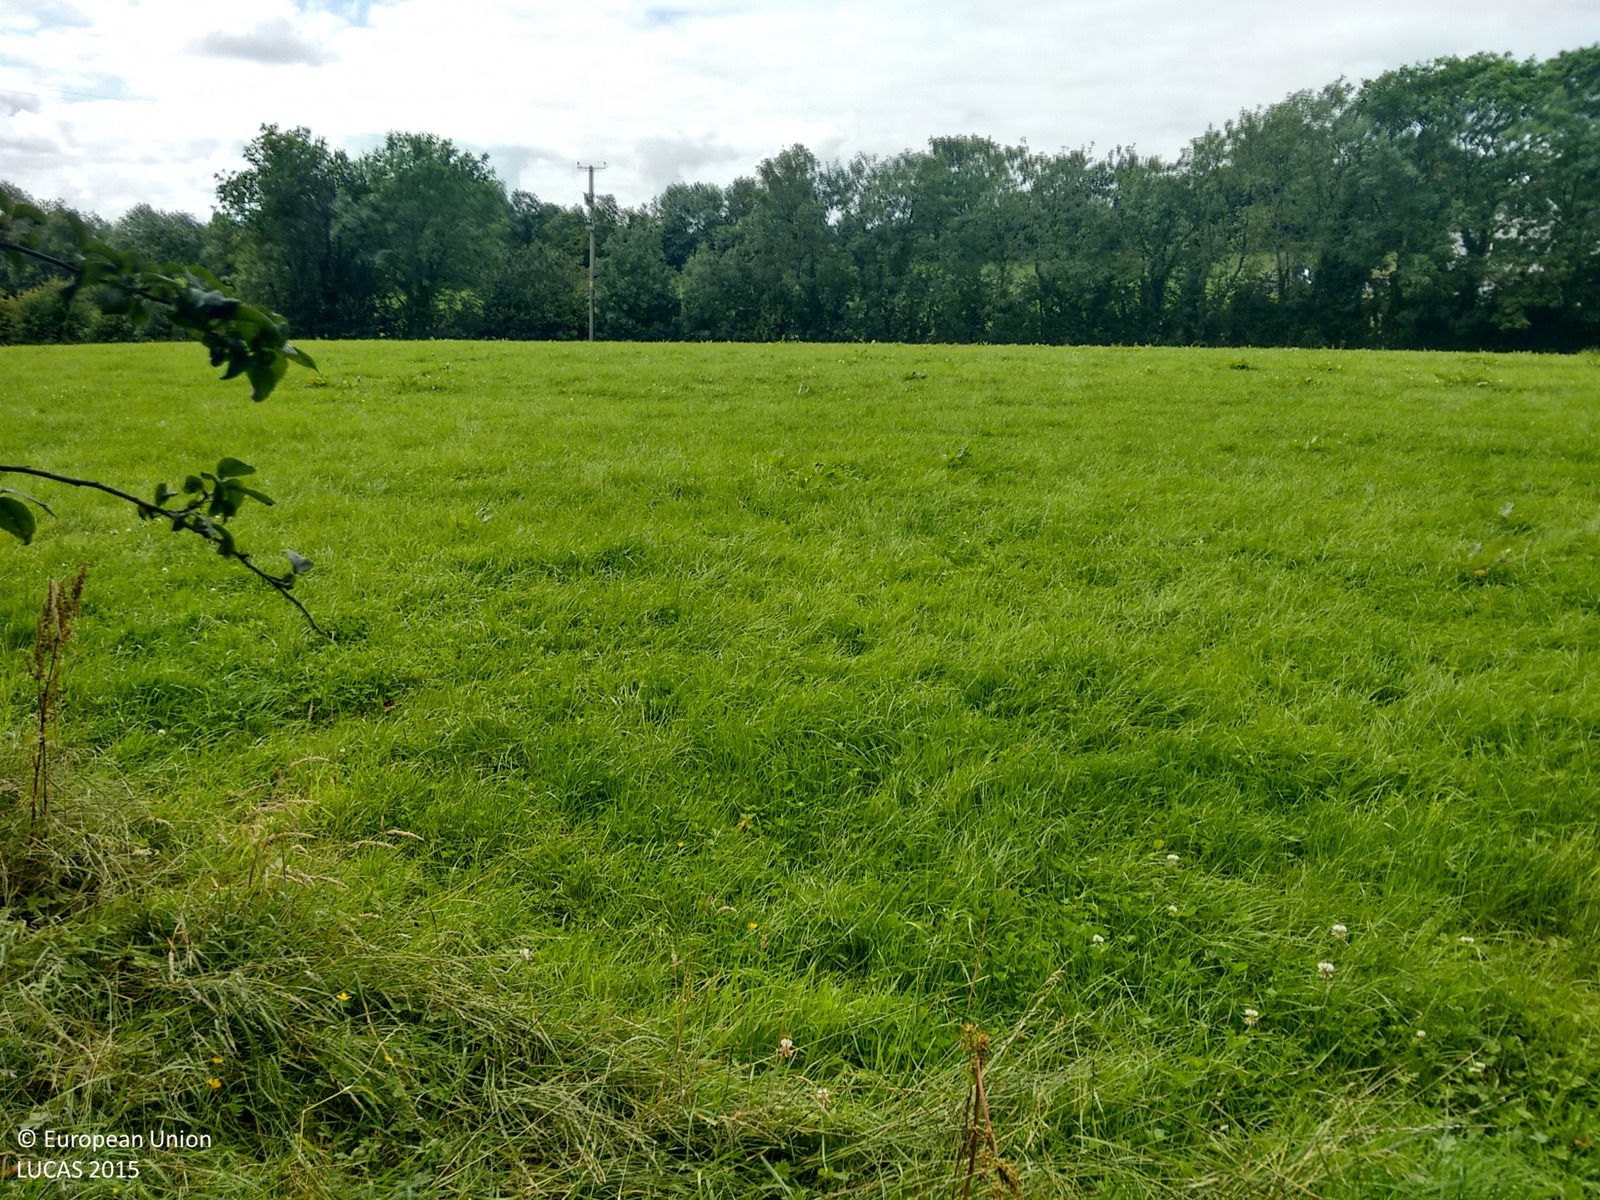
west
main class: Woodland
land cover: Broadleaved woodland
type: mesophytic deciduous forest
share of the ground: > 75 %
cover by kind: broadleaved forest trees 100 %
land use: Abandoned areas
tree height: > 5 m
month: August
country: GB
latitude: 54.3147
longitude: -6.6542
